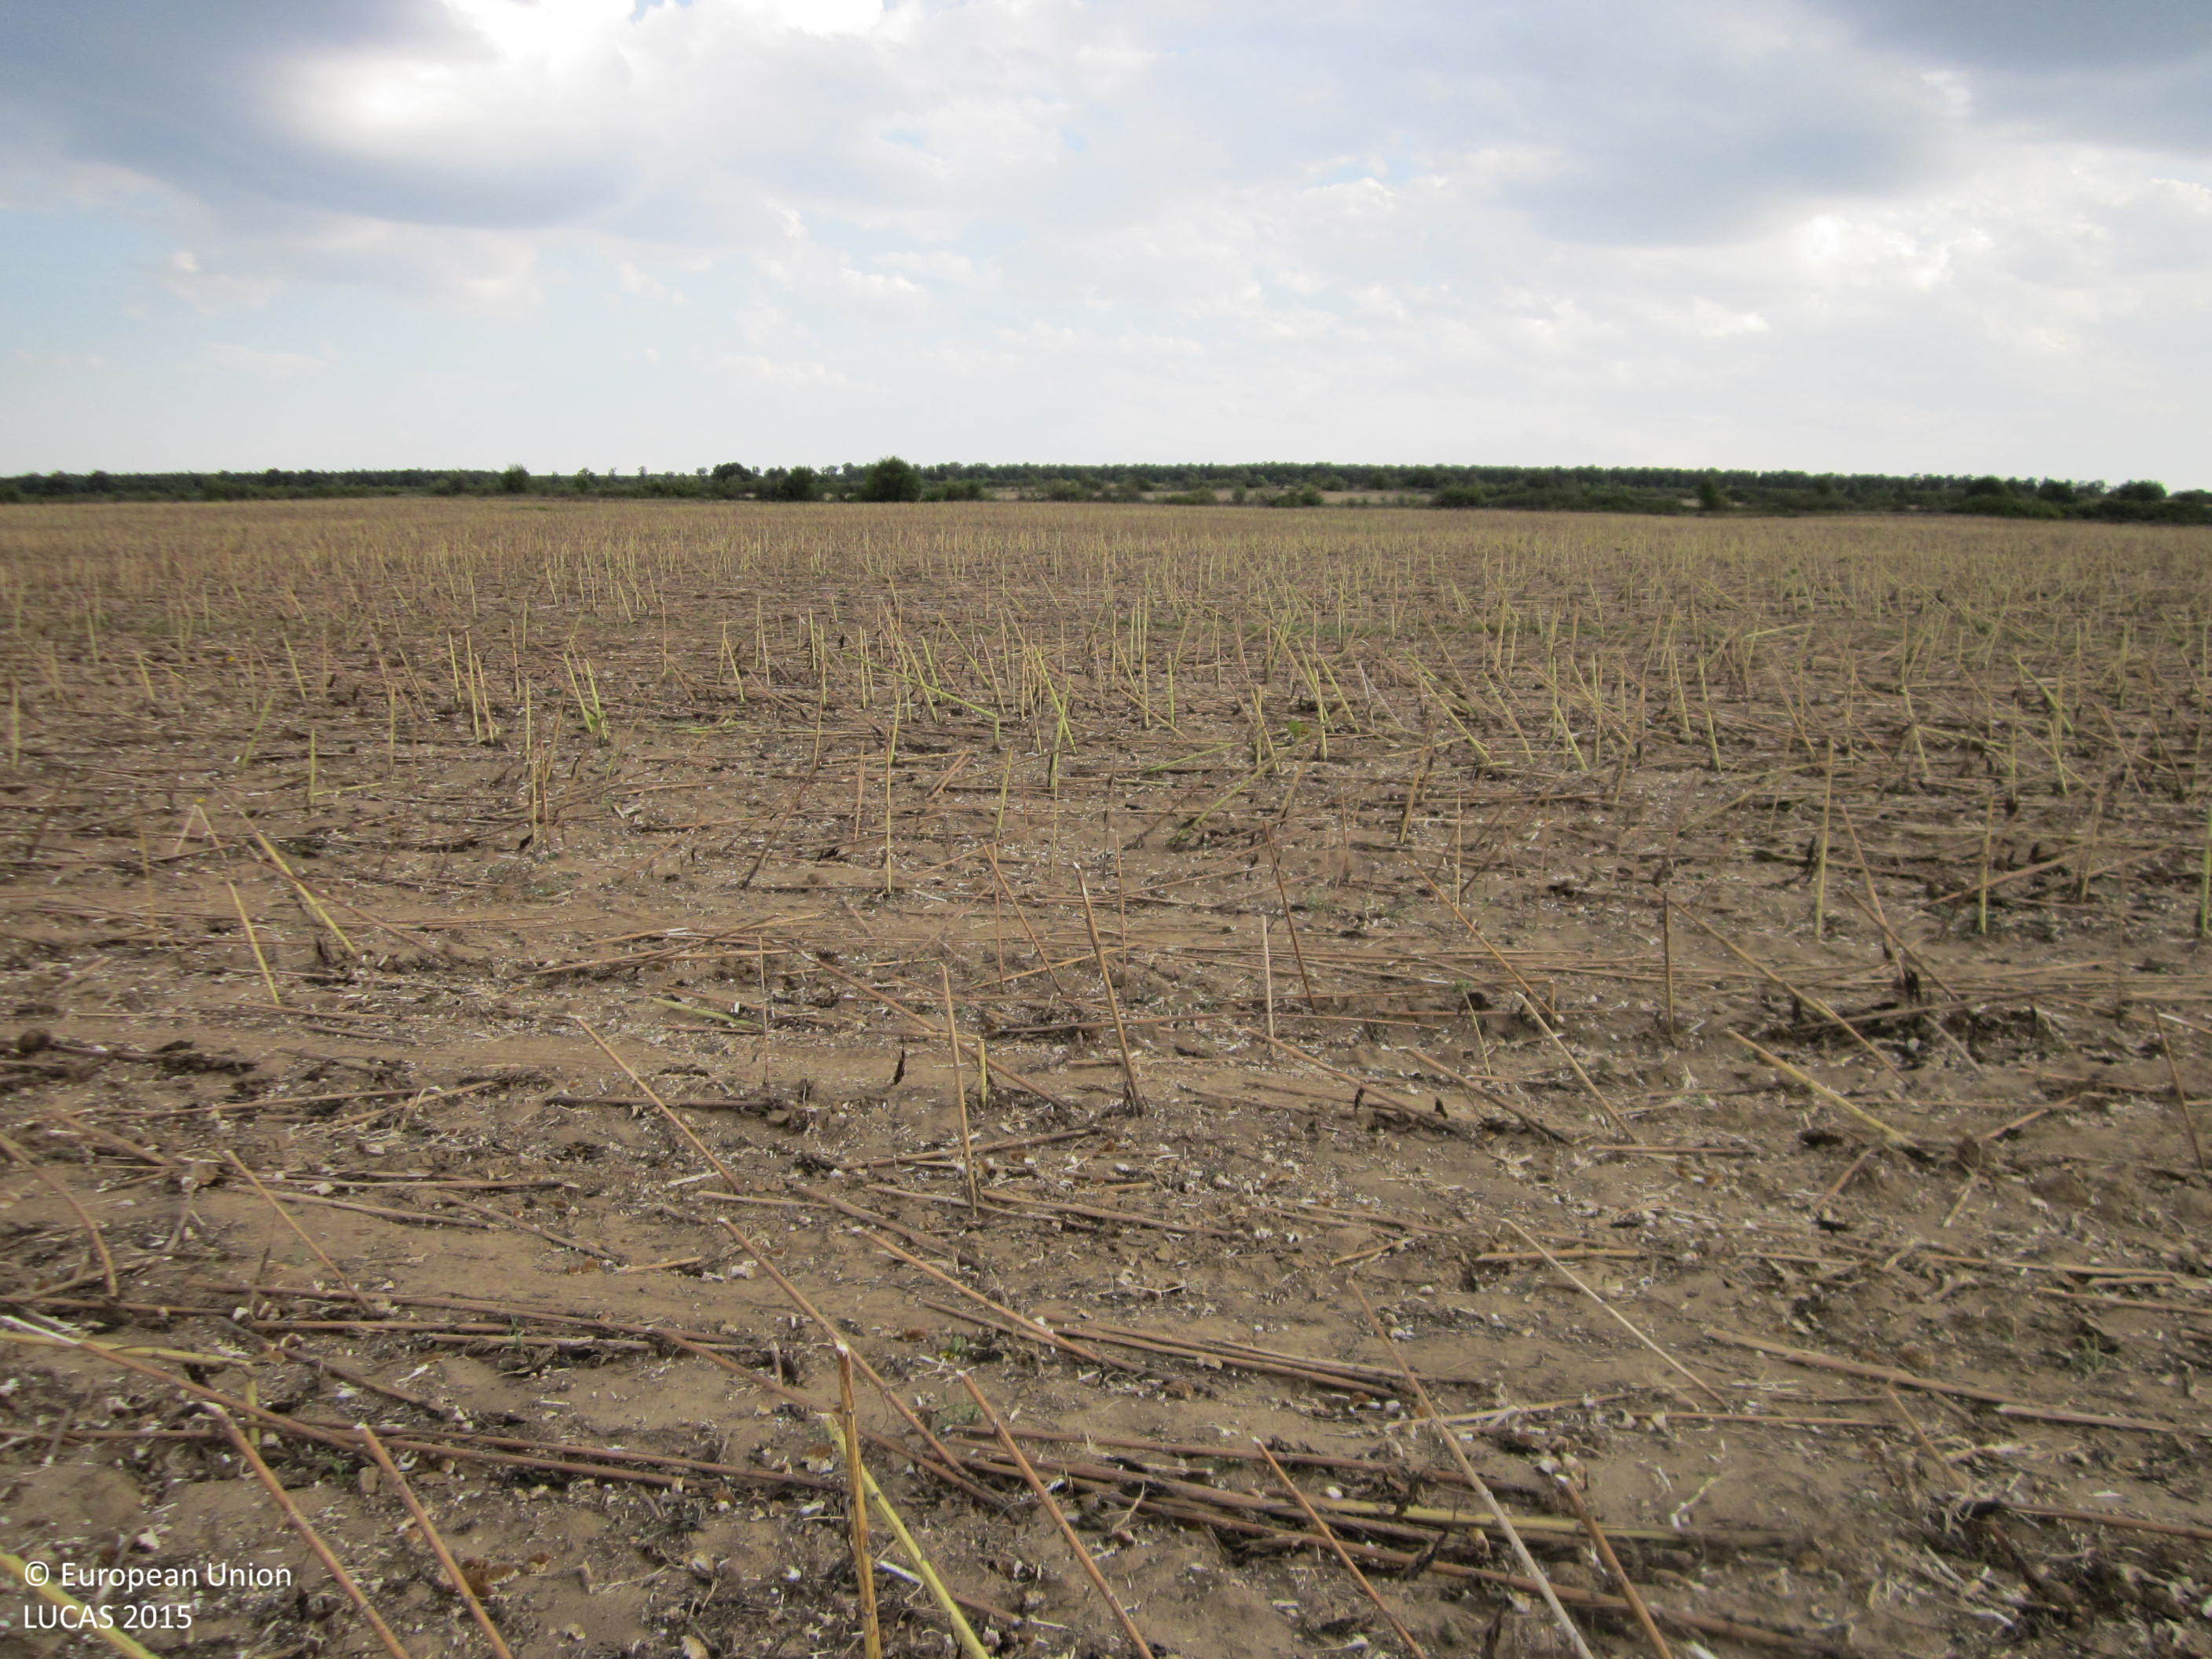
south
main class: Cropland
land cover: Sunflower
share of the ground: 25 - 50 %
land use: Agriculture (excluding fallow land and kitchen gardens)
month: September
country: BG
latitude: 42.7888
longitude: 27.3173
